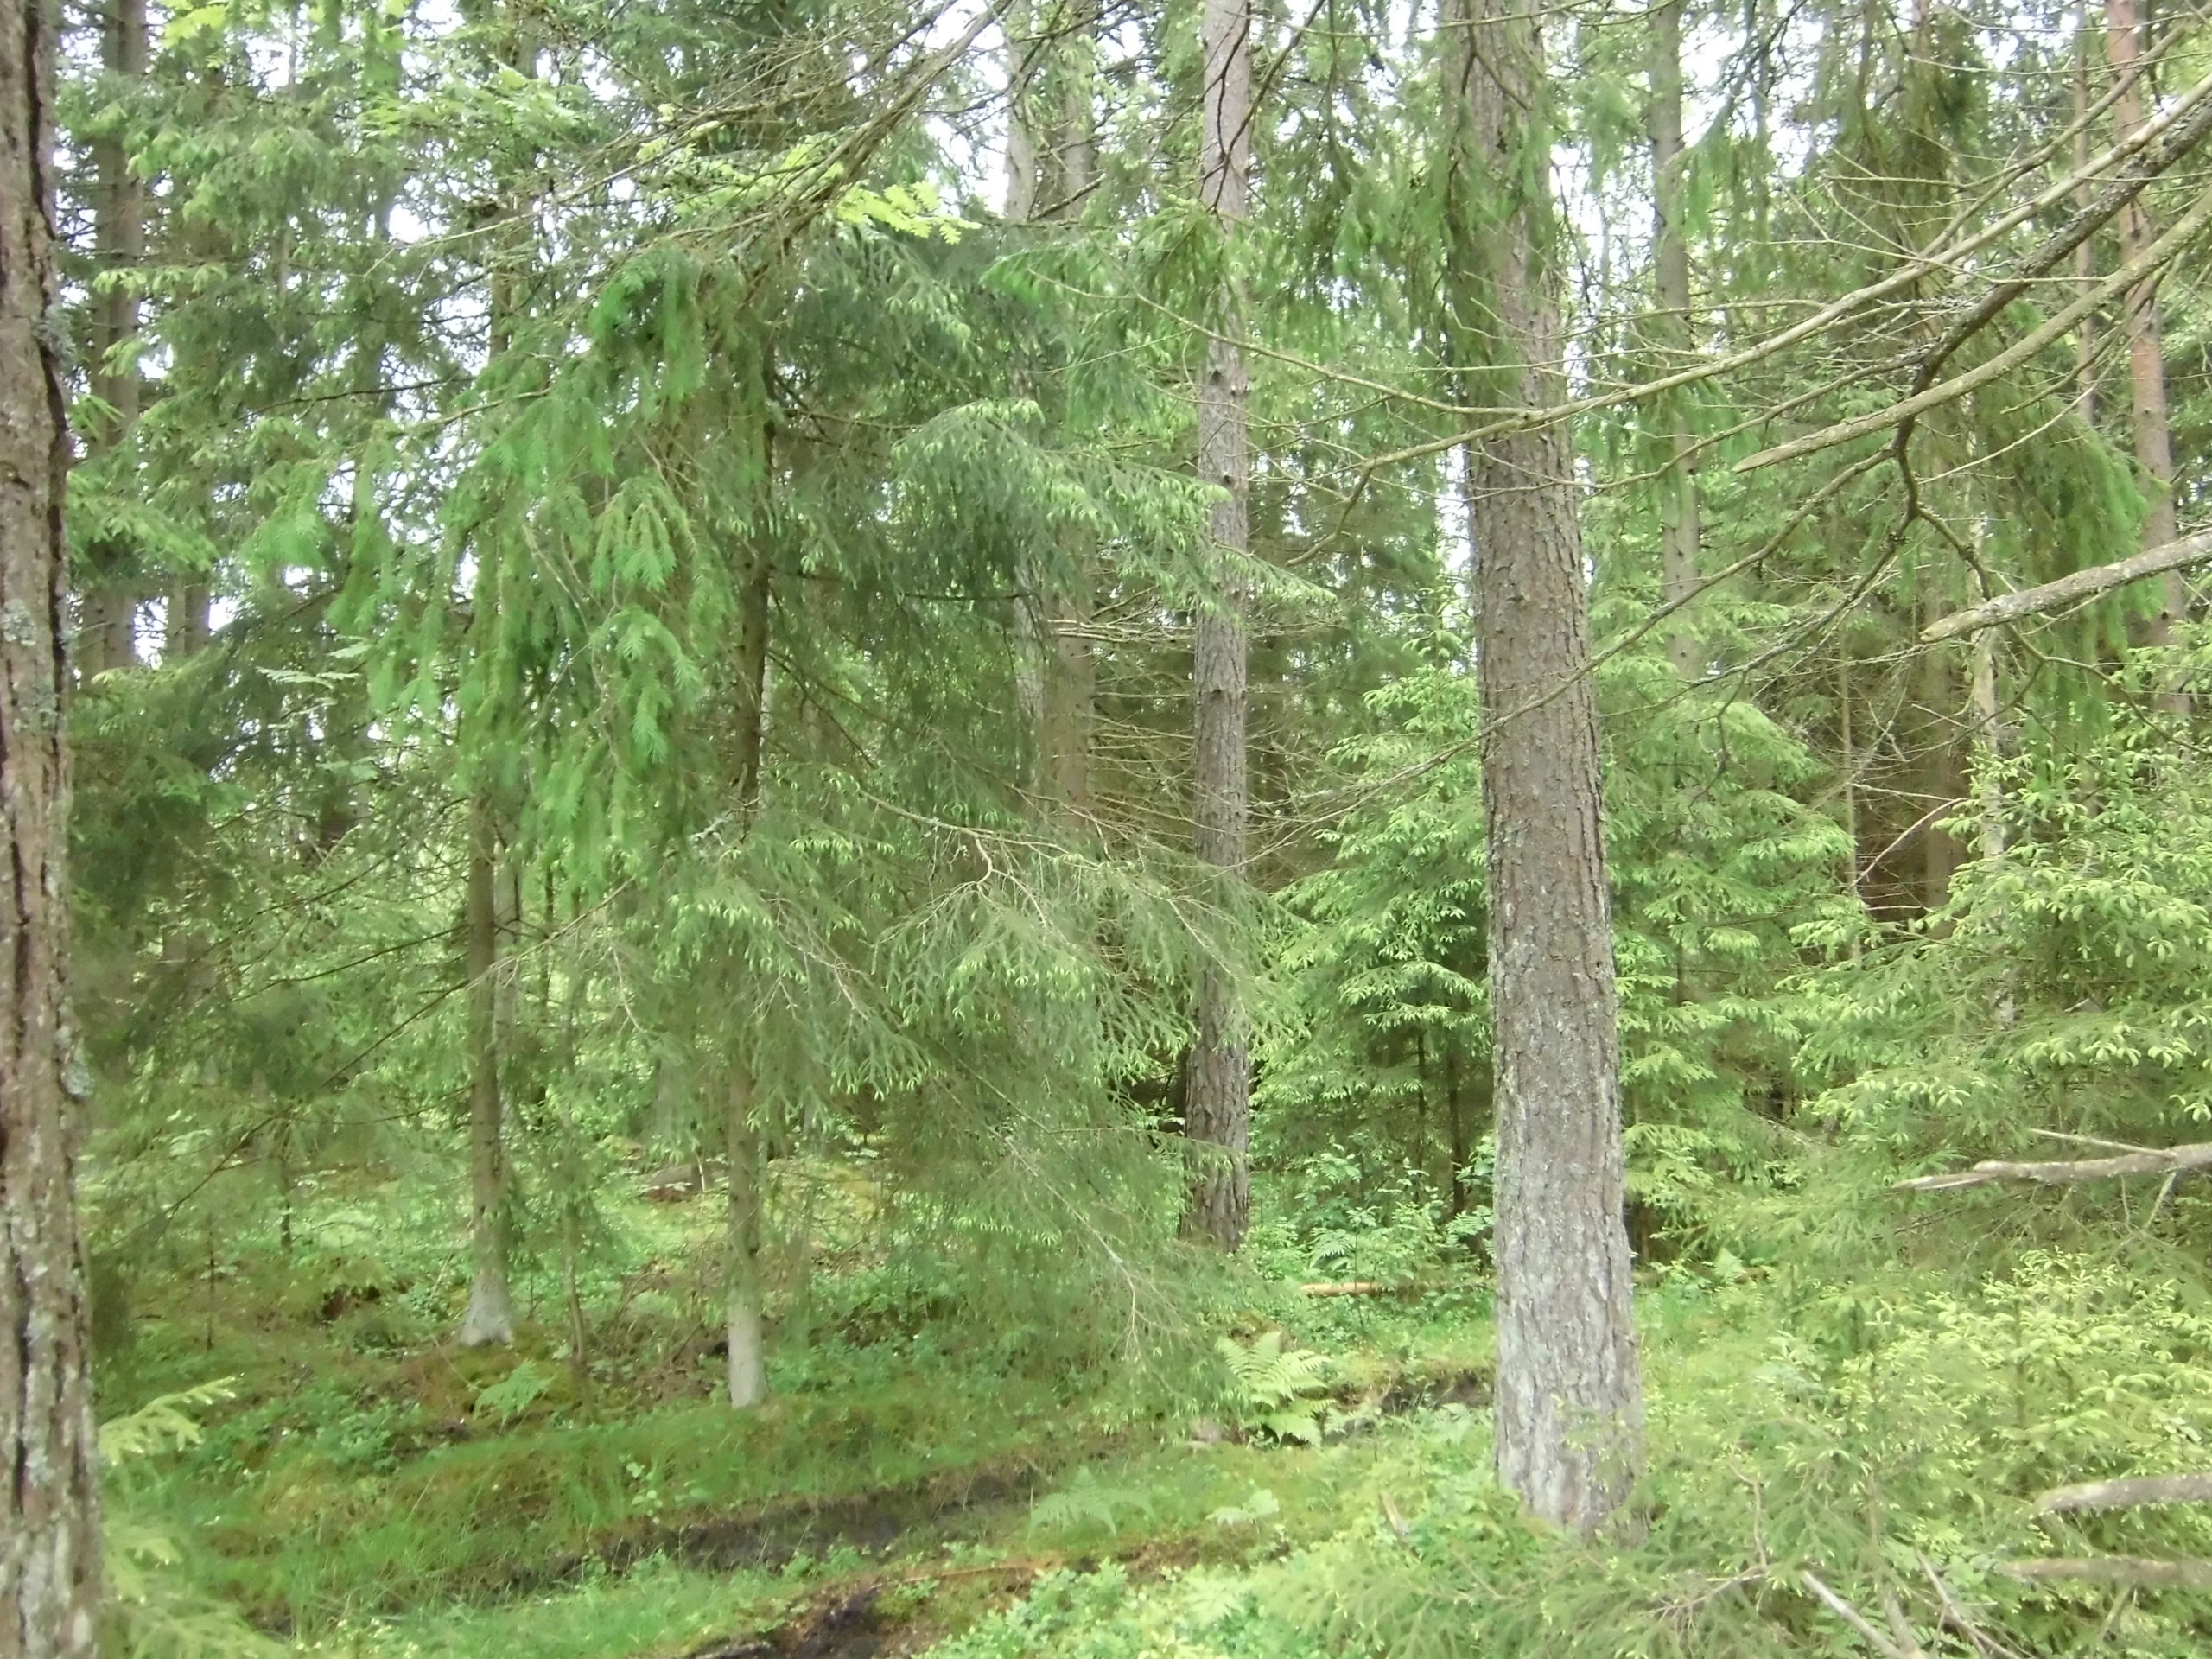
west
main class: Woodland
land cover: Spruce dominated coniferous woodland
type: boreal forest
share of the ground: 50 - 75 %
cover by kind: coniferous forest trees 55 %, shrubs 15 %, broadleaved forest trees 10 %, herbaceous plants 10 %, lichens and mosses 10 %
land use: Forestry
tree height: > 5 m
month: June
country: SE
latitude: 57.0159
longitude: 14.8225
